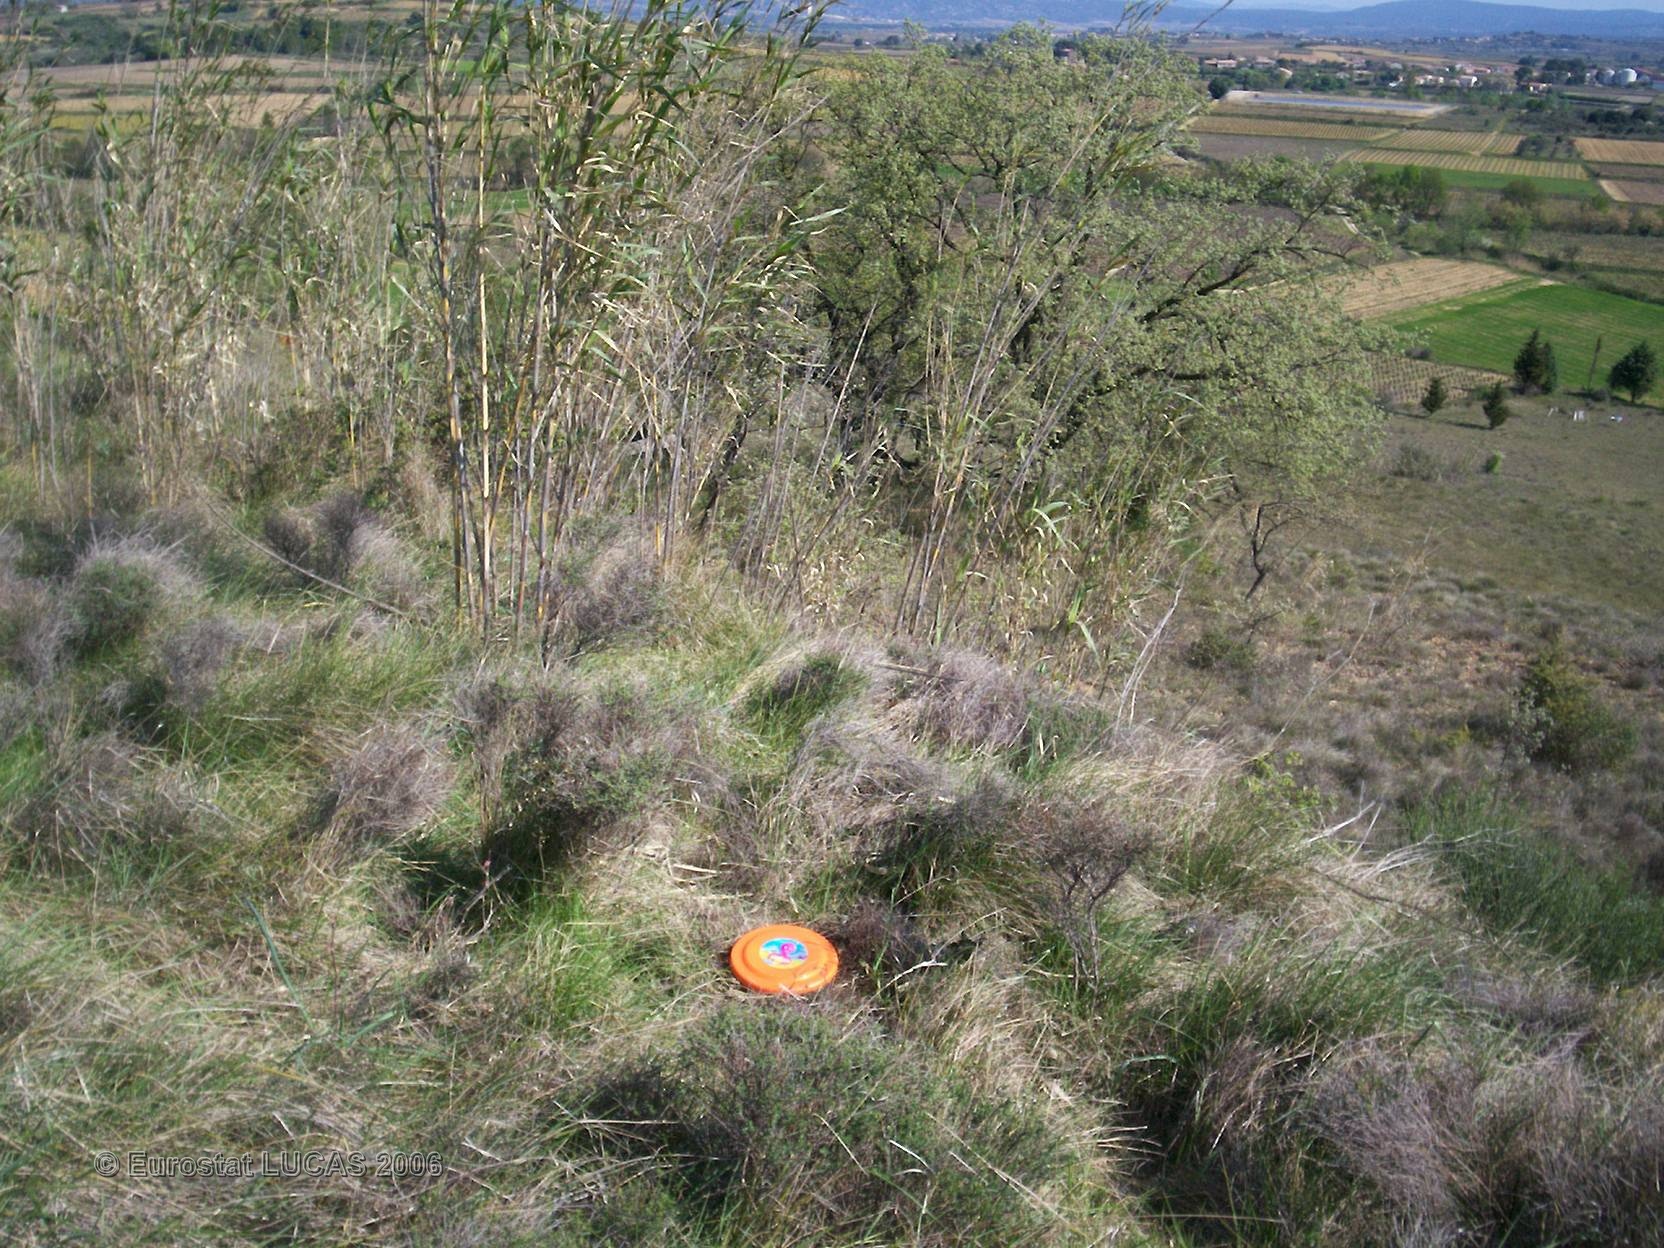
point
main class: Grassland
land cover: Grassland with sparse tree/shrub cover
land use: Unused
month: April
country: FR
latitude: 43.6057
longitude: 3.5293
